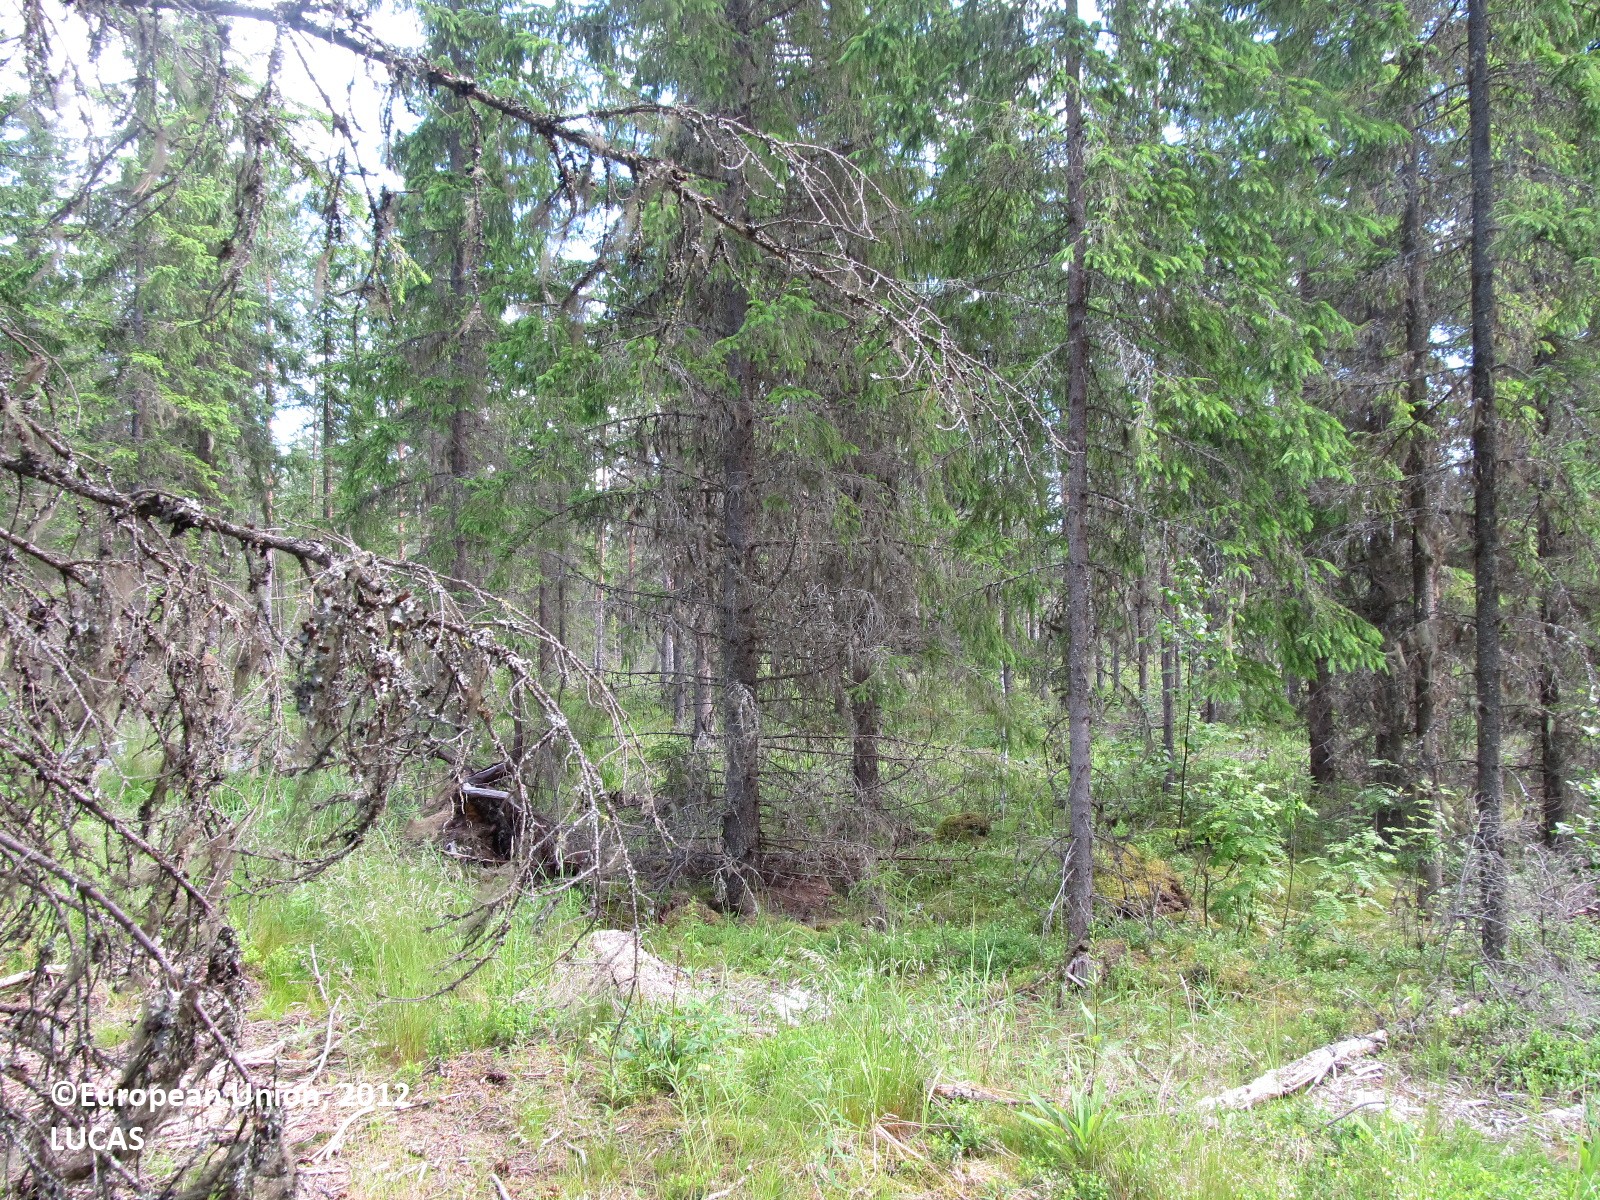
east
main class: Woodland
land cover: Spruce dominated coniferous woodland
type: boreal forest
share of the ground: 50 - 75 %
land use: Forestry
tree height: > 5 m
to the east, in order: Spruce dominated coniferous woodland; Pine dominated coniferous woodland; Other bare soil; Ditches and canals; Other bare soil
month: July
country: FI
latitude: 62.4395
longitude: 28.9124
